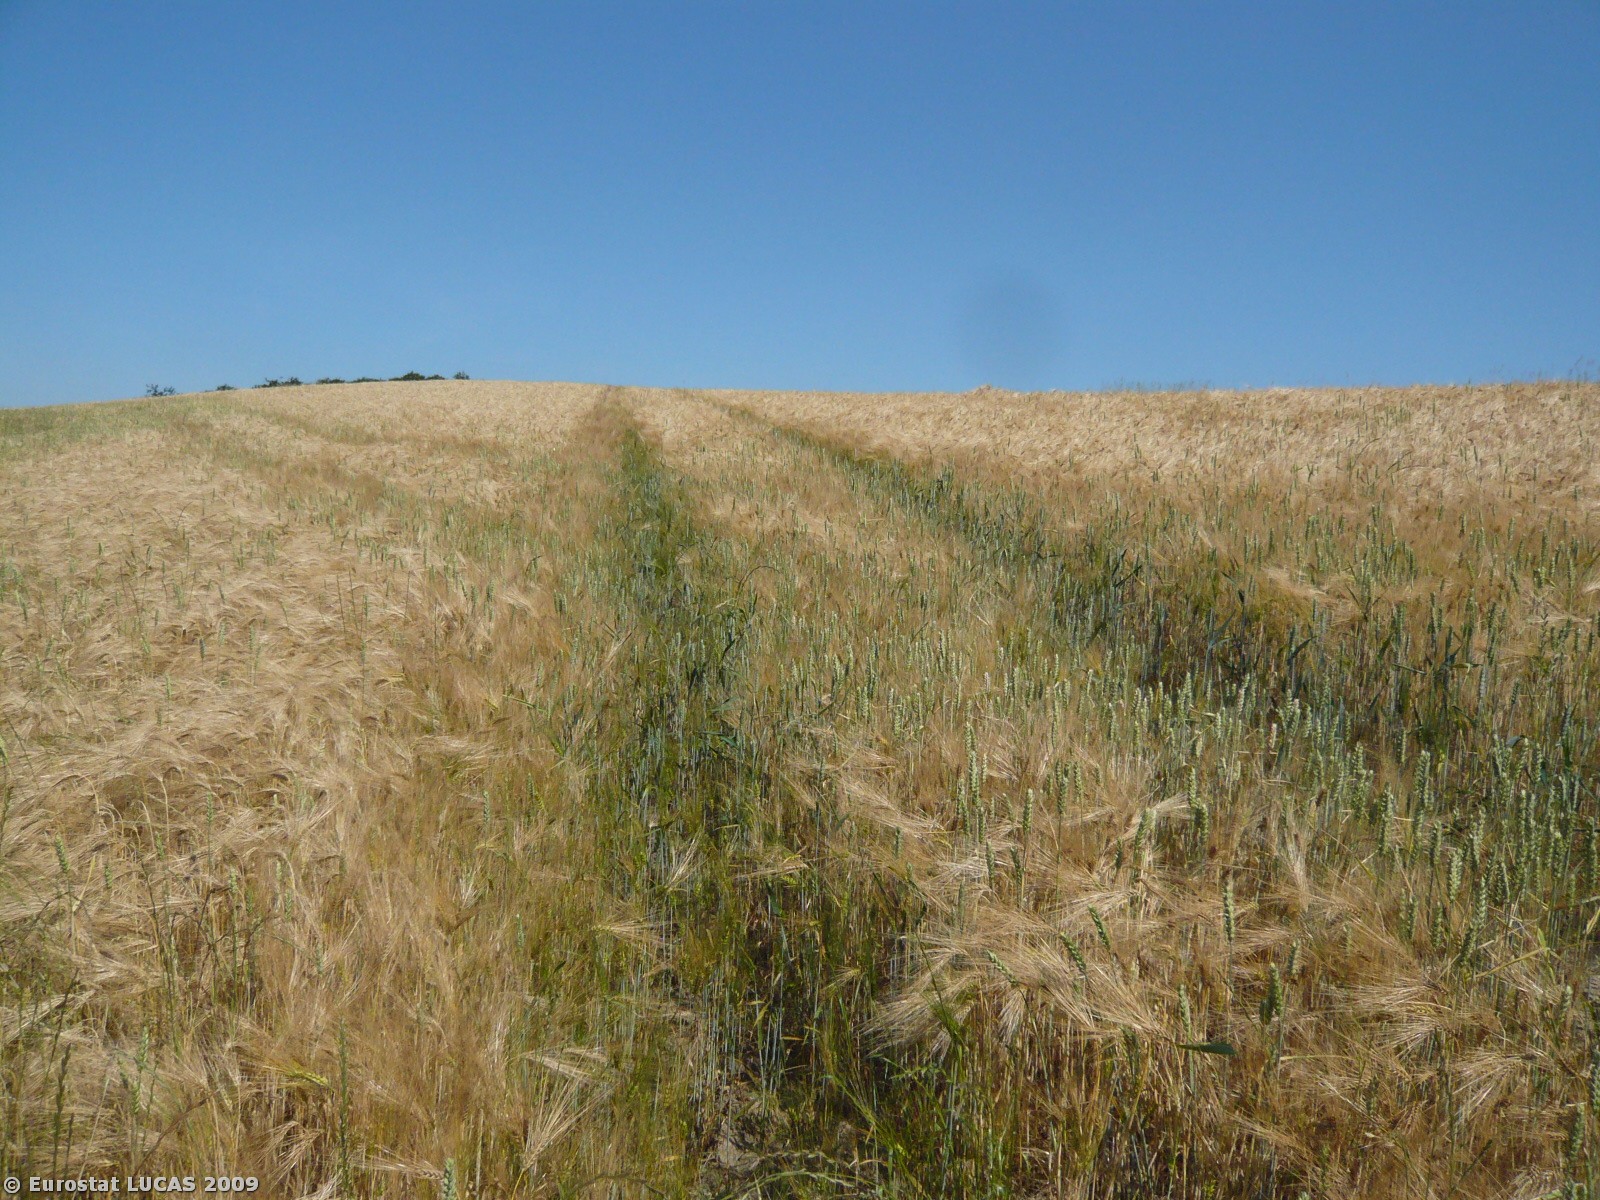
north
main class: Cropland
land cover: Barley
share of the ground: > 75 %
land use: Agriculture (excluding fallow land and kitchen gardens)
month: July
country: DK
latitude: 55.3069
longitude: 10.1417
